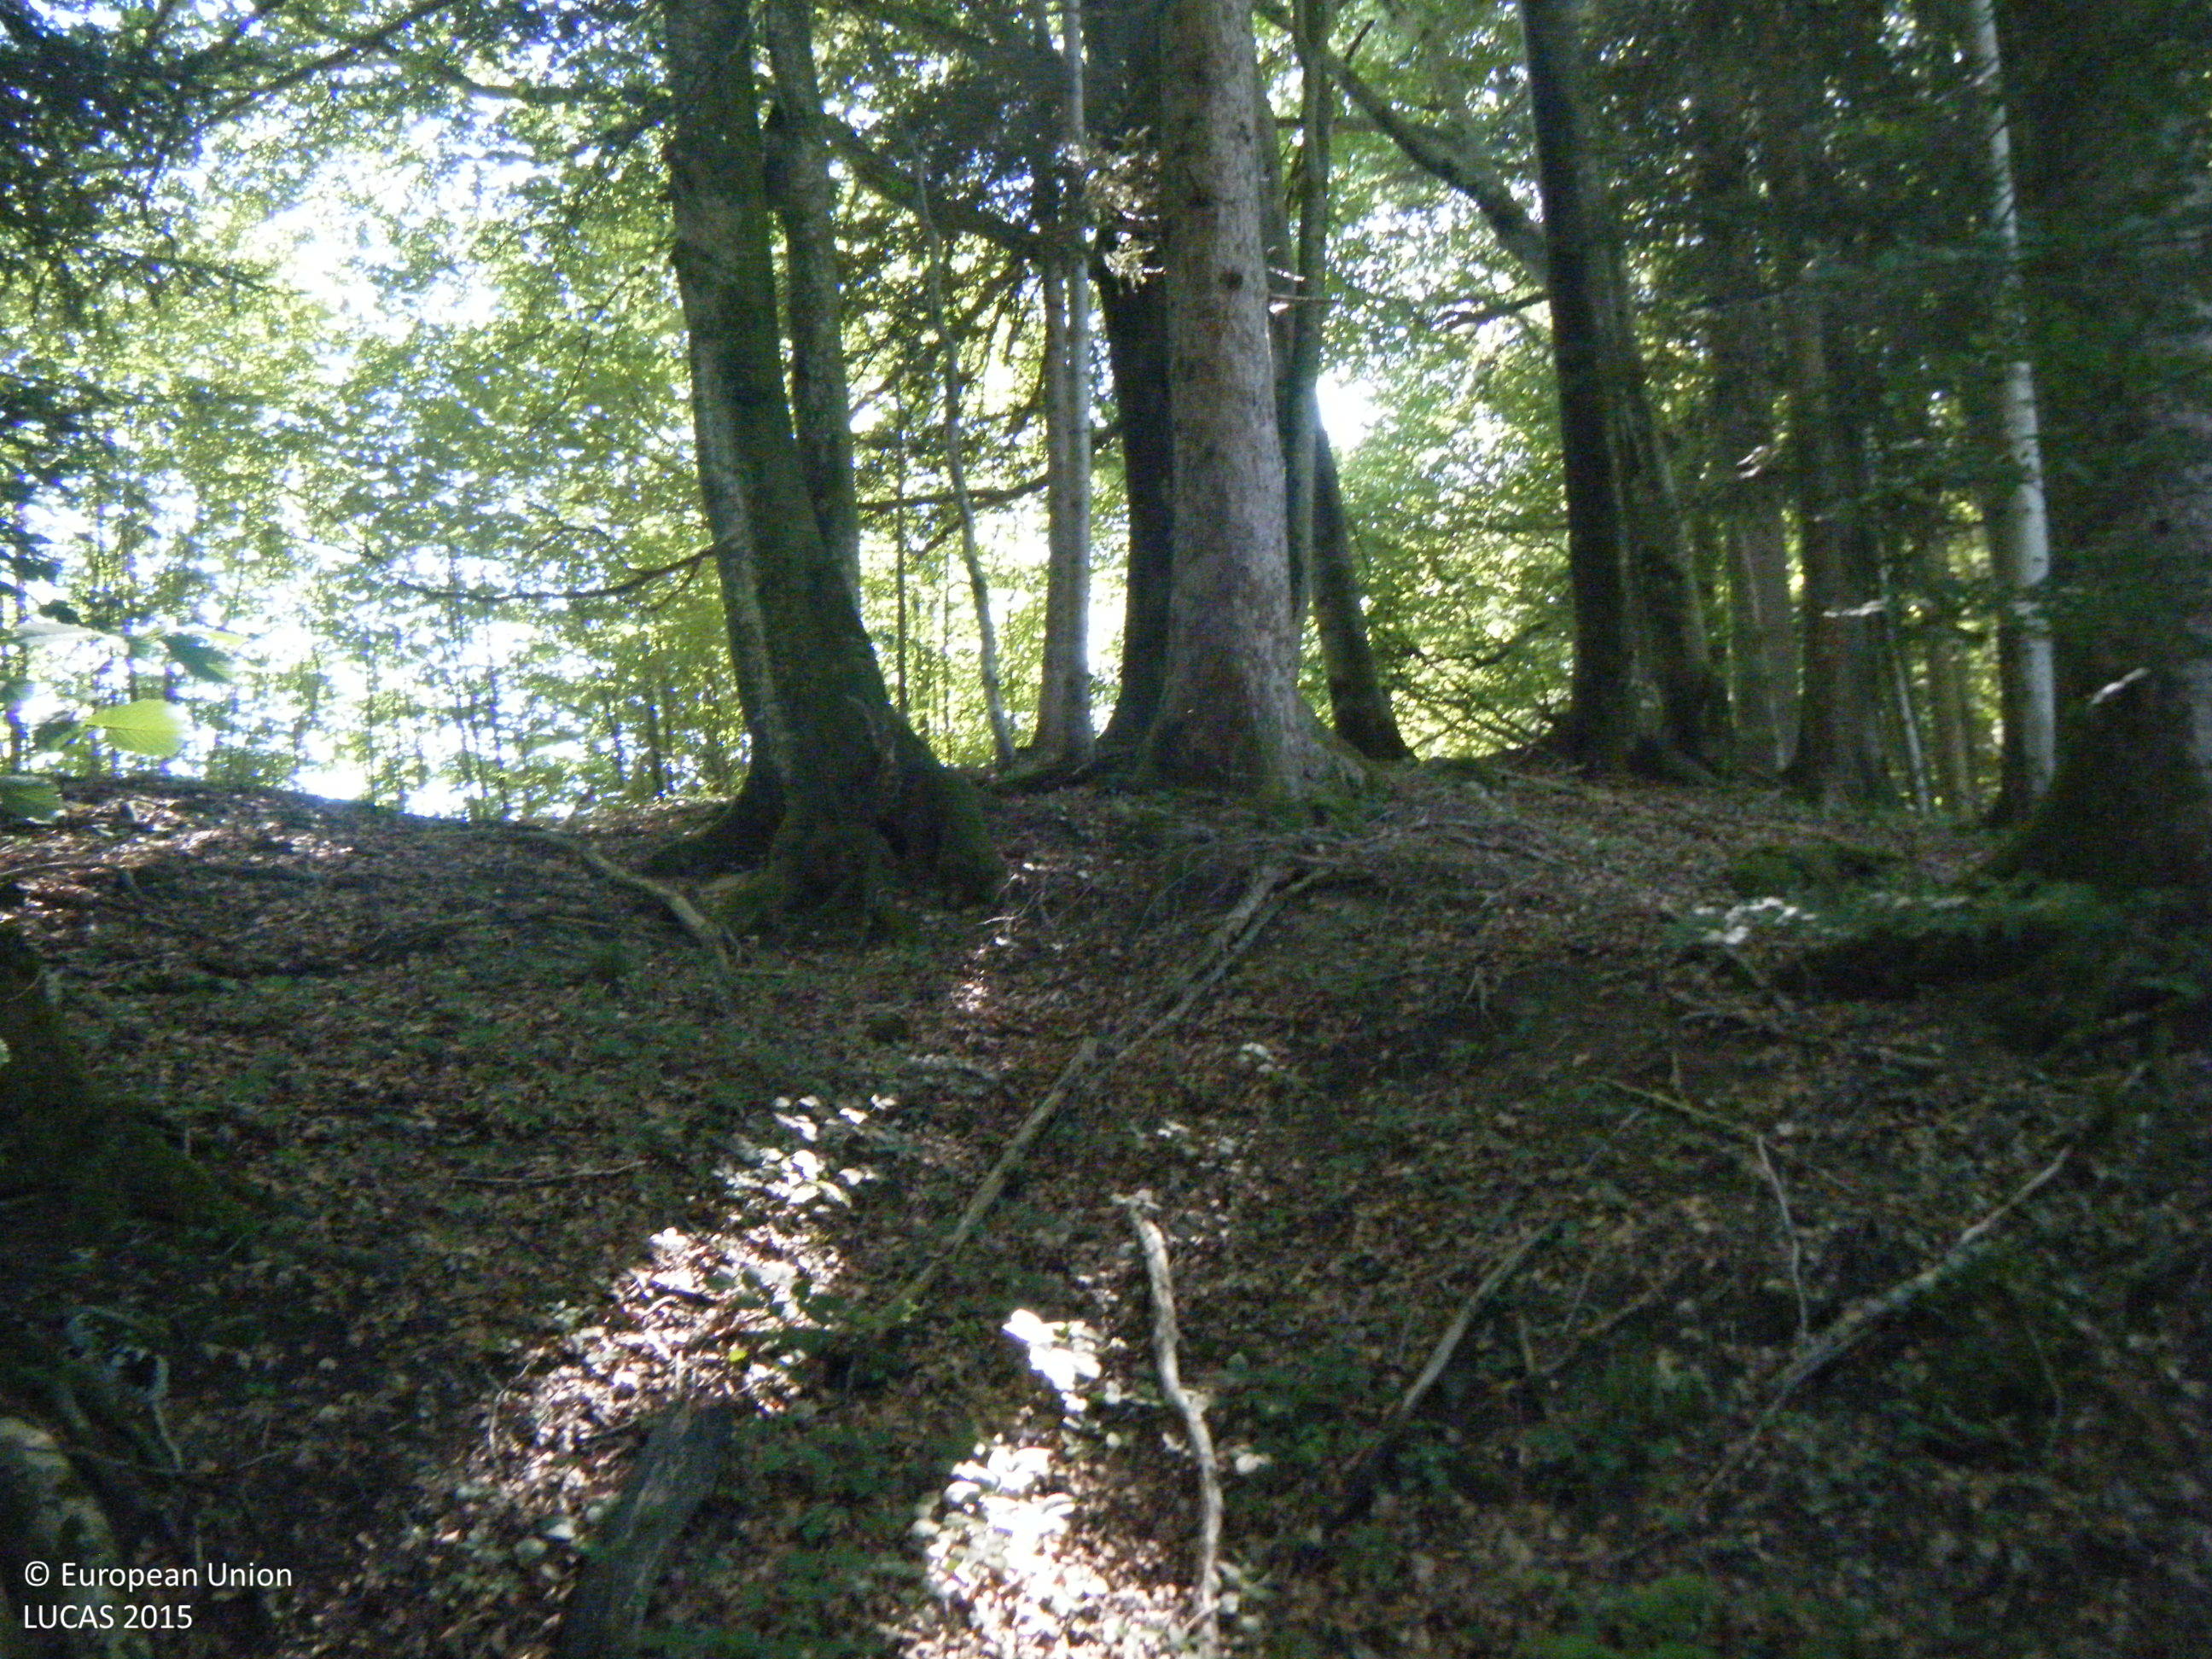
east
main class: Woodland
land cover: Broadleaved woodland
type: beech forest
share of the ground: > 75 %
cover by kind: broadleaved forest trees 70 %, coniferous forest trees 20 %, lichens and mosses 5 %, unconsolidated bare surface 5 %
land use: Forestry
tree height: > 5 m
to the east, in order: Broadleaved woodland; Ditches and canals; Broadleaved woodland; Spontaneously vegetated surfaces; Fences; Grassland with sparse tree/shrub cover; Fences; Grassland without tree/shrub cover; Fences; Grassland with sparse tree/shrub cover; Fences; Other bare soil; Fences; Other bare soil; Artificial constructions in urban areas; Grassland without tree/shrub cover
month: July
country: AT
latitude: 47.7765
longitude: 13.3483
